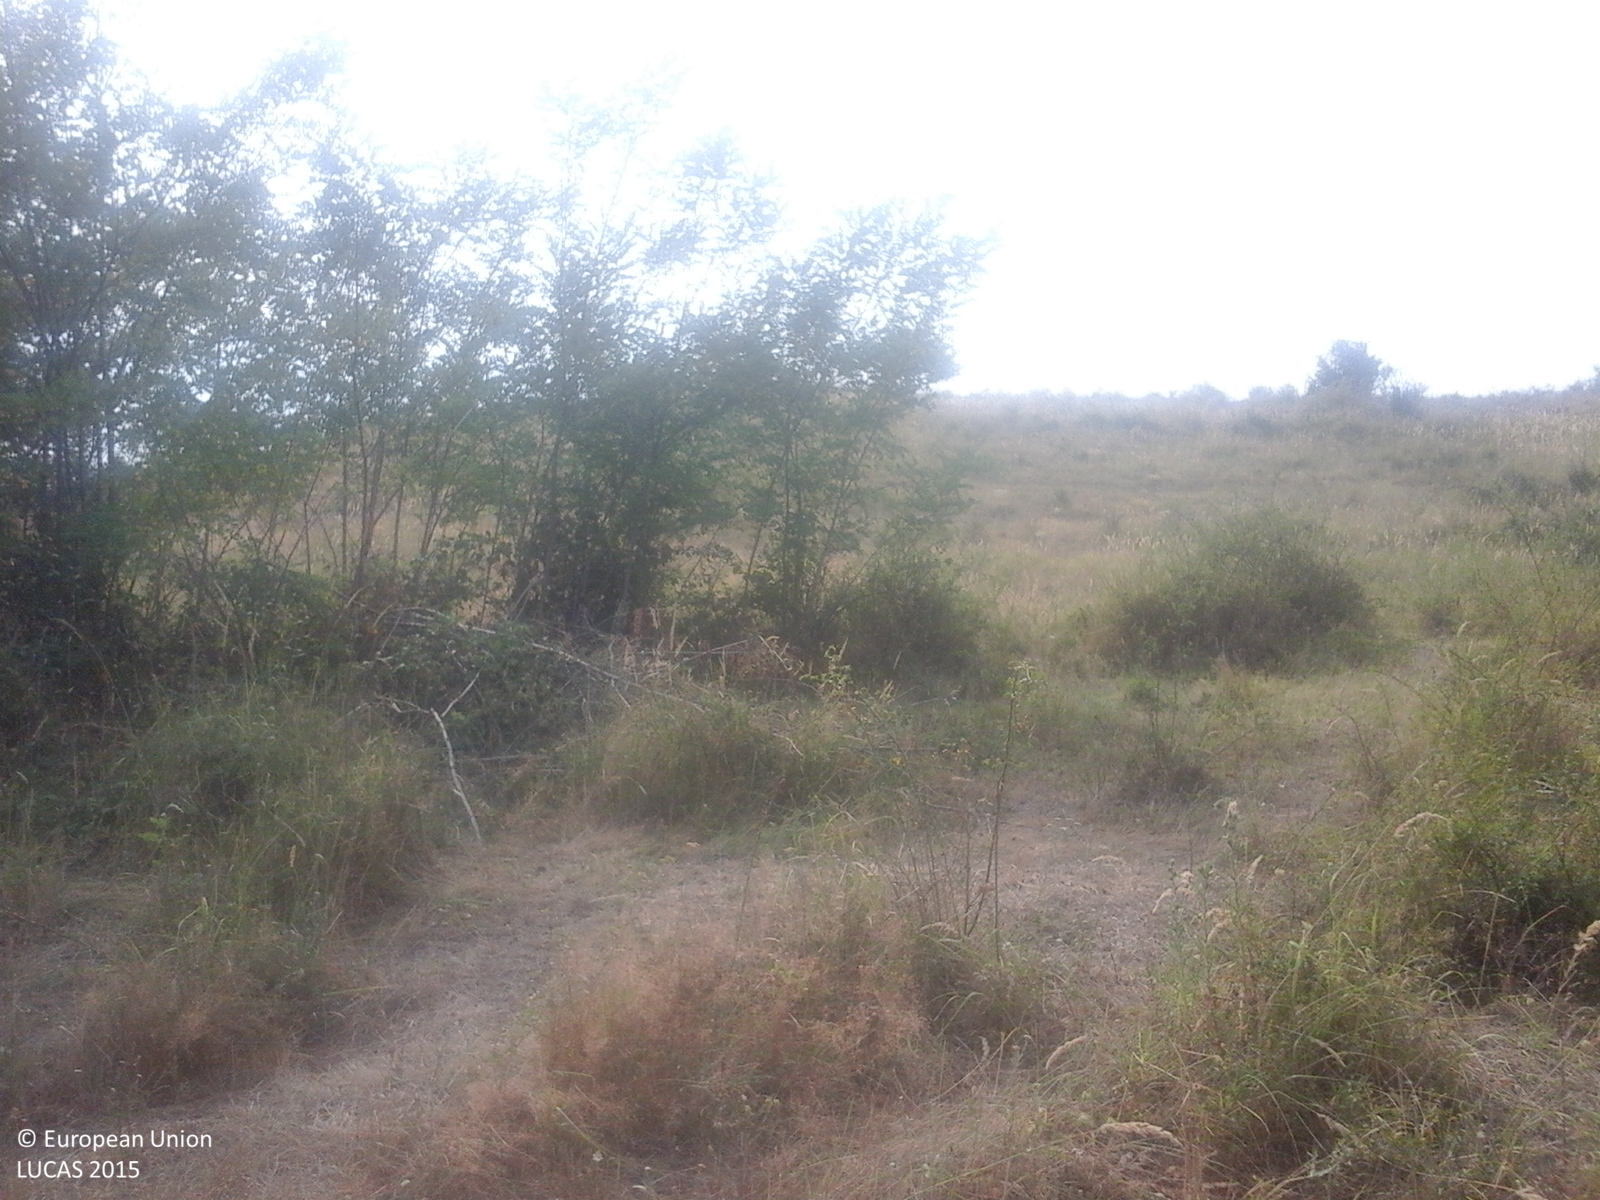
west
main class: Woodland
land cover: Broadleaved woodland
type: exotic forest
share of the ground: > 75 %
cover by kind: broadleaved forest trees 100 %
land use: Forestry
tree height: > 5 m
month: August
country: RO
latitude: 44.8601
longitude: 23.7147
